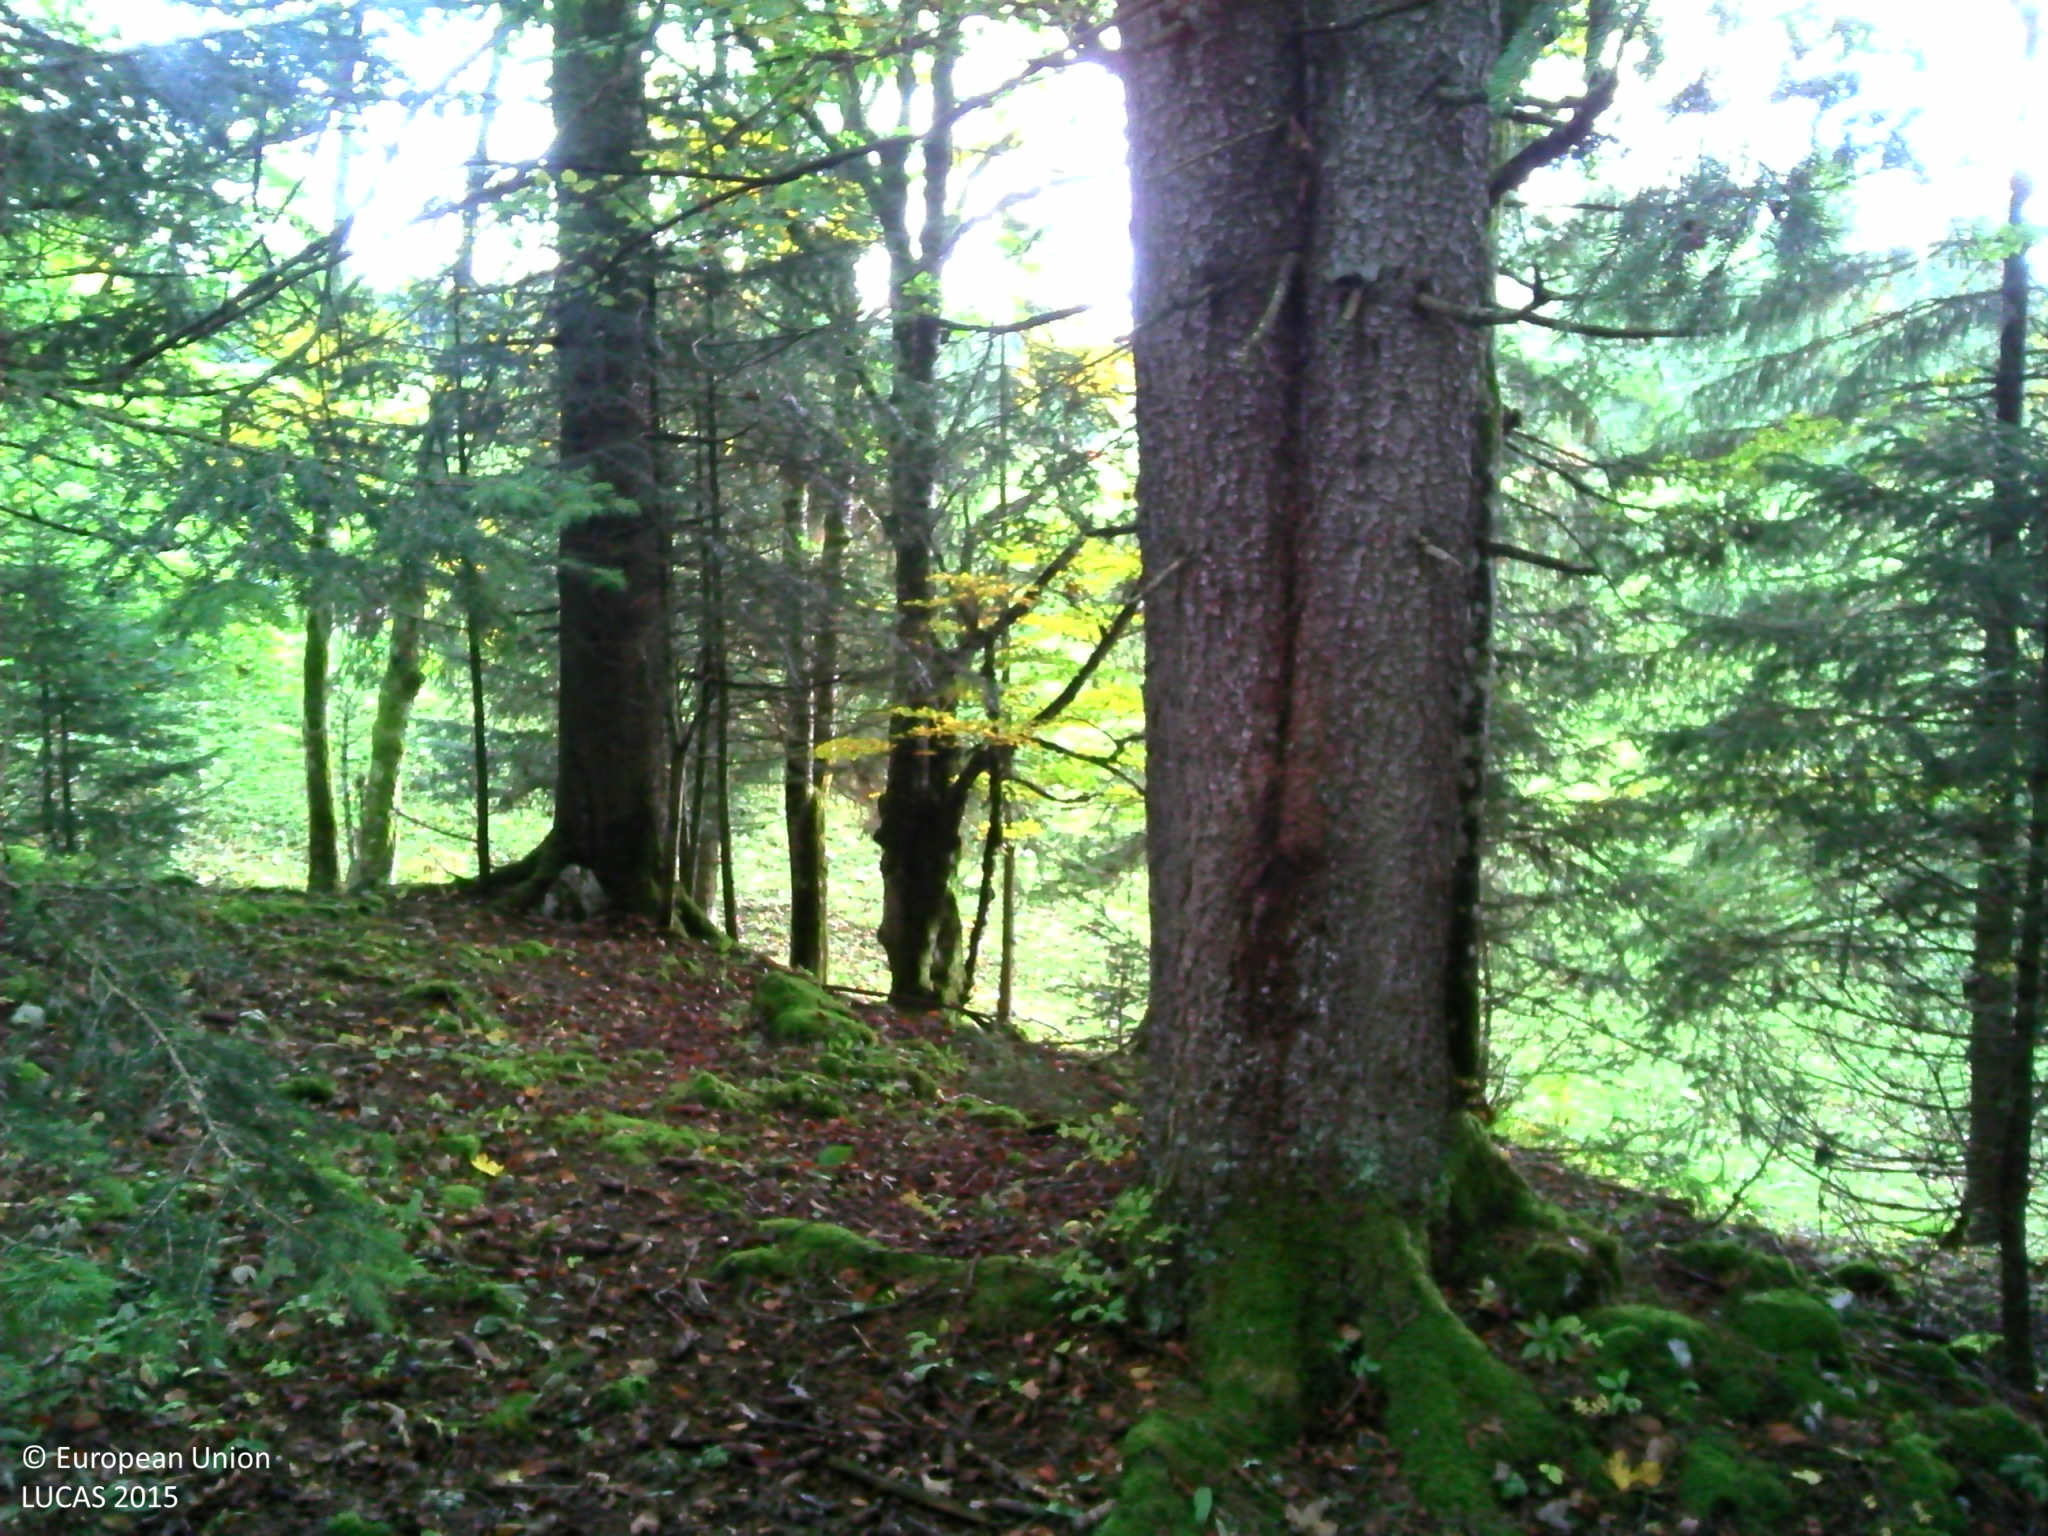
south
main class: Woodland
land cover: Spruce dominated mixed woodland
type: mountainous beech forest
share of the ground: > 75 %
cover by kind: coniferous forest trees 60 %, broadleaved forest trees 40 %
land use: Agriculture (excluding fallow land and kitchen gardens)
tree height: > 5 m
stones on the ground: < 10 %
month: October
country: FR
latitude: 46.7388
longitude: 6.3250
